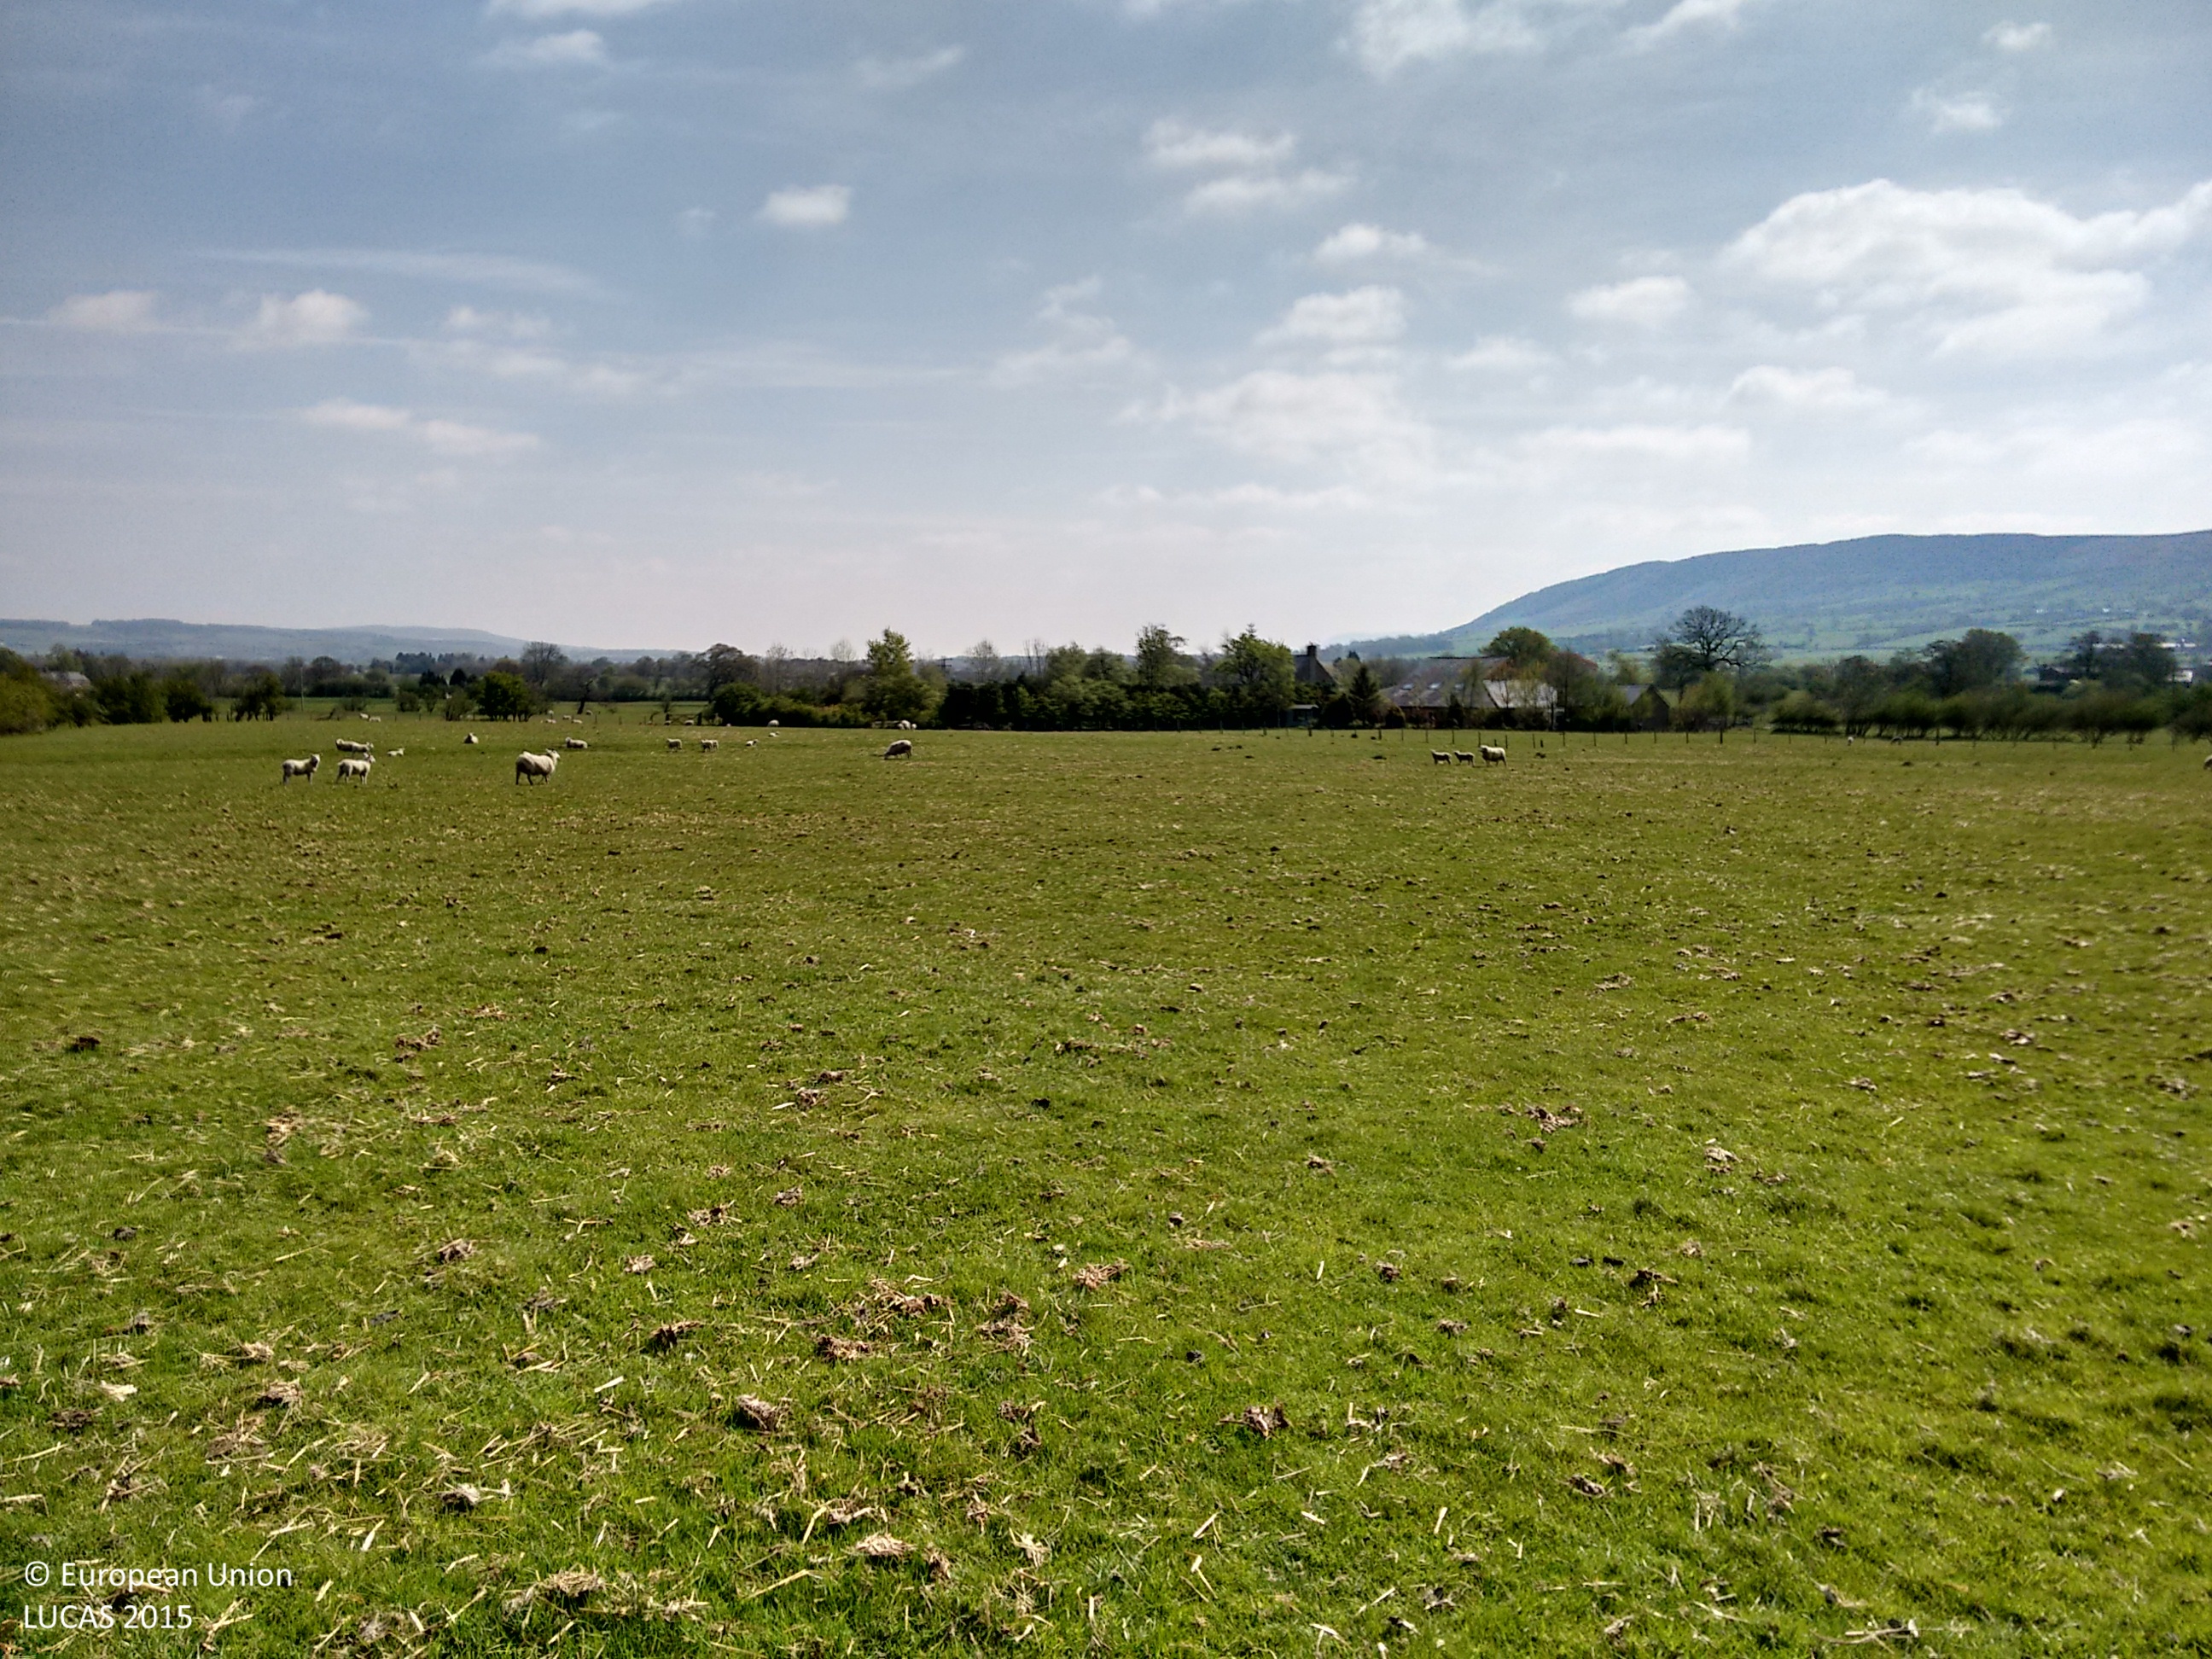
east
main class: Grassland
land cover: Grassland without tree/shrub cover
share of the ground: > 75 %
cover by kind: herbaceous plants 100 %
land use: Agriculture (excluding fallow land and kitchen gardens)
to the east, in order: Grassland without tree/shrub cover; Fences; Grassland without tree/shrub cover; Managed hedges; Artificial constructions in urban areas; Grassland without tree/shrub cover; Electric lines; Grassland without tree/shrub cover; Lines of trees; Grass margins
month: May
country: GB
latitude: 53.8712
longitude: -2.5831
